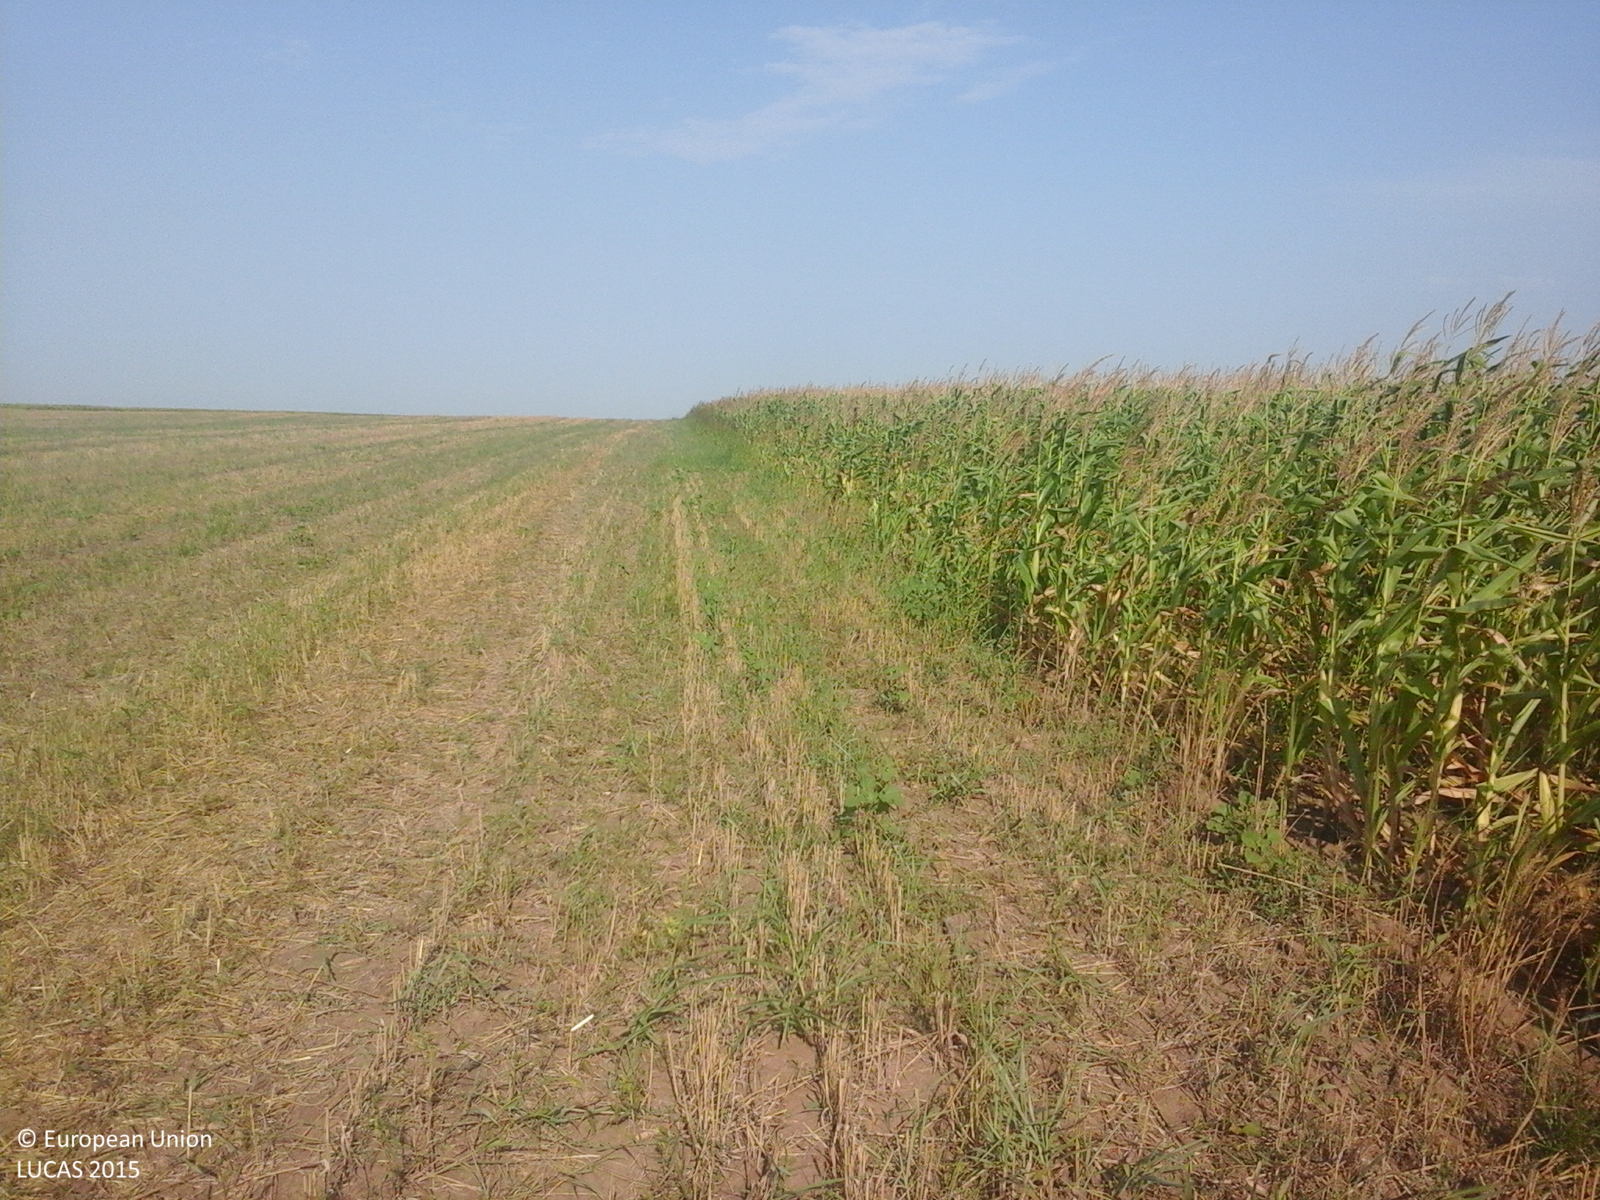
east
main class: Cropland
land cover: Maize
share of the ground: > 75 %
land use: Agriculture (excluding fallow land and kitchen gardens)
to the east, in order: Maize
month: August
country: RO
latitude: 43.9187
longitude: 28.1257
